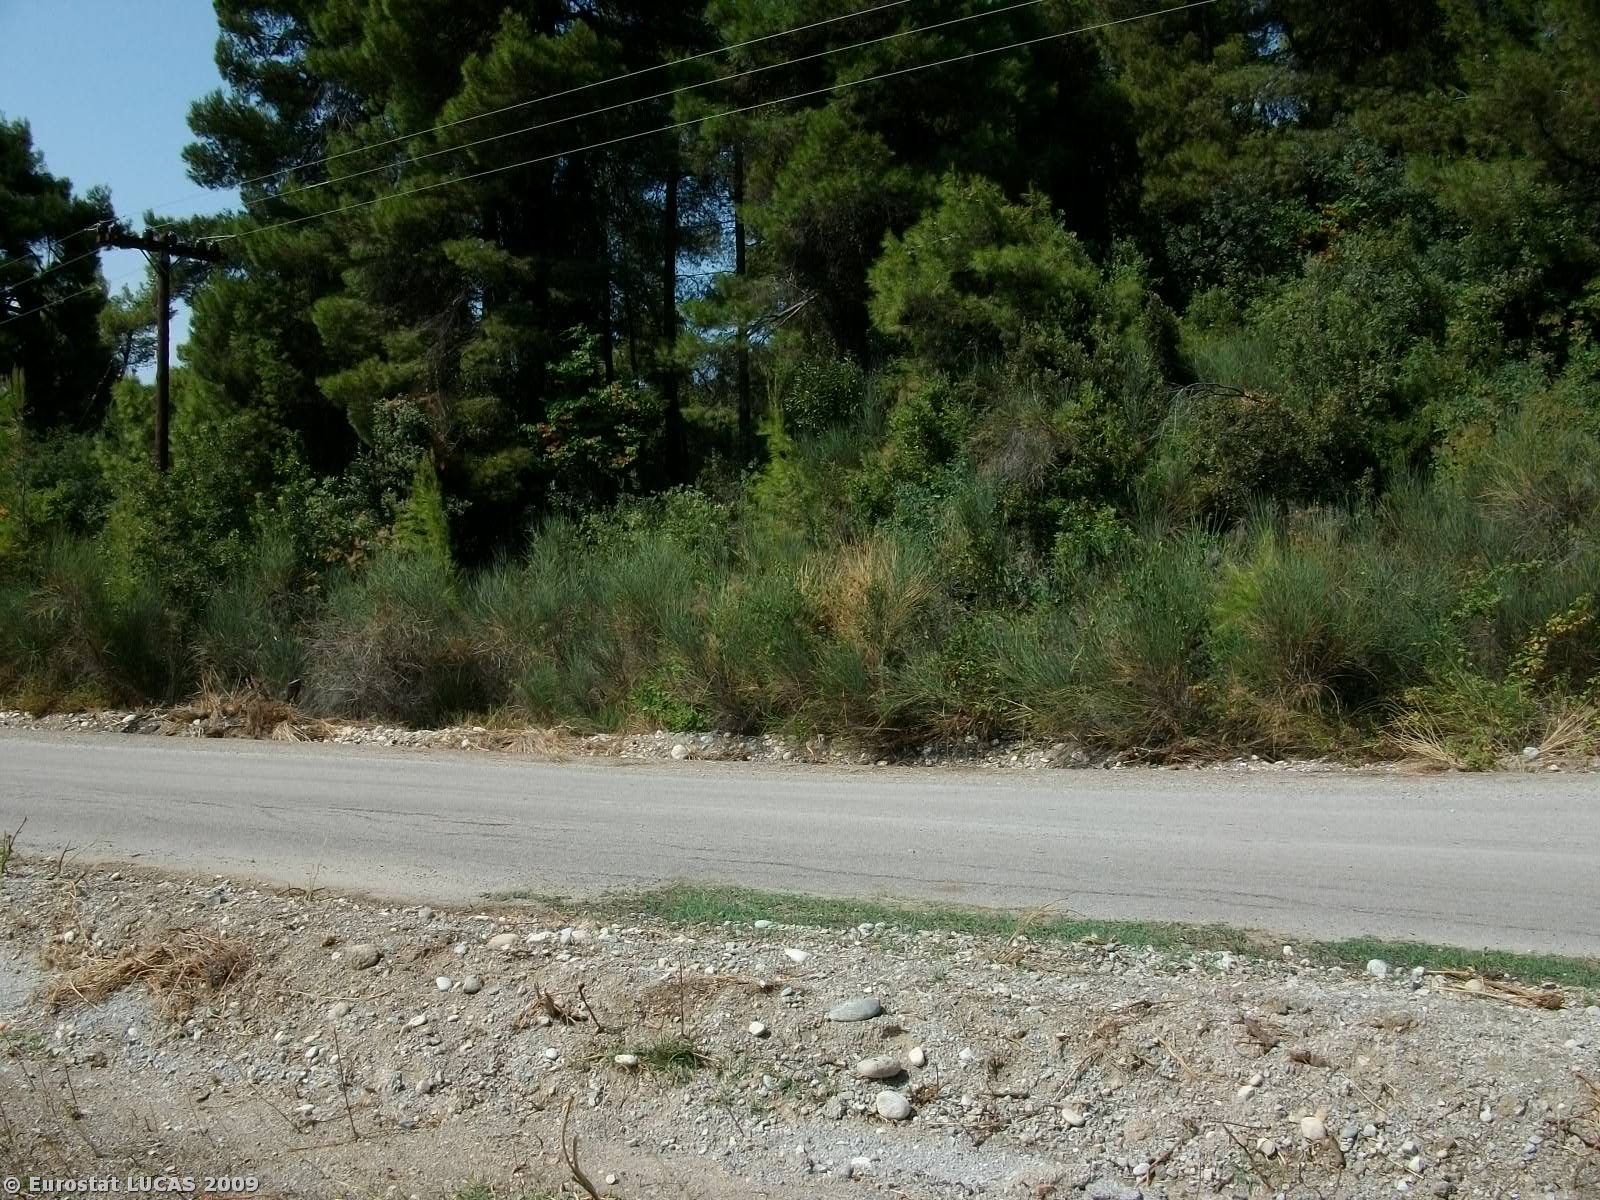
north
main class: Shrubland
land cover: Shrubland without tree cover
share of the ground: 25 - 50 %
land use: Fallow land
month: August
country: GR
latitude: 38.8995
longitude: 23.1668
